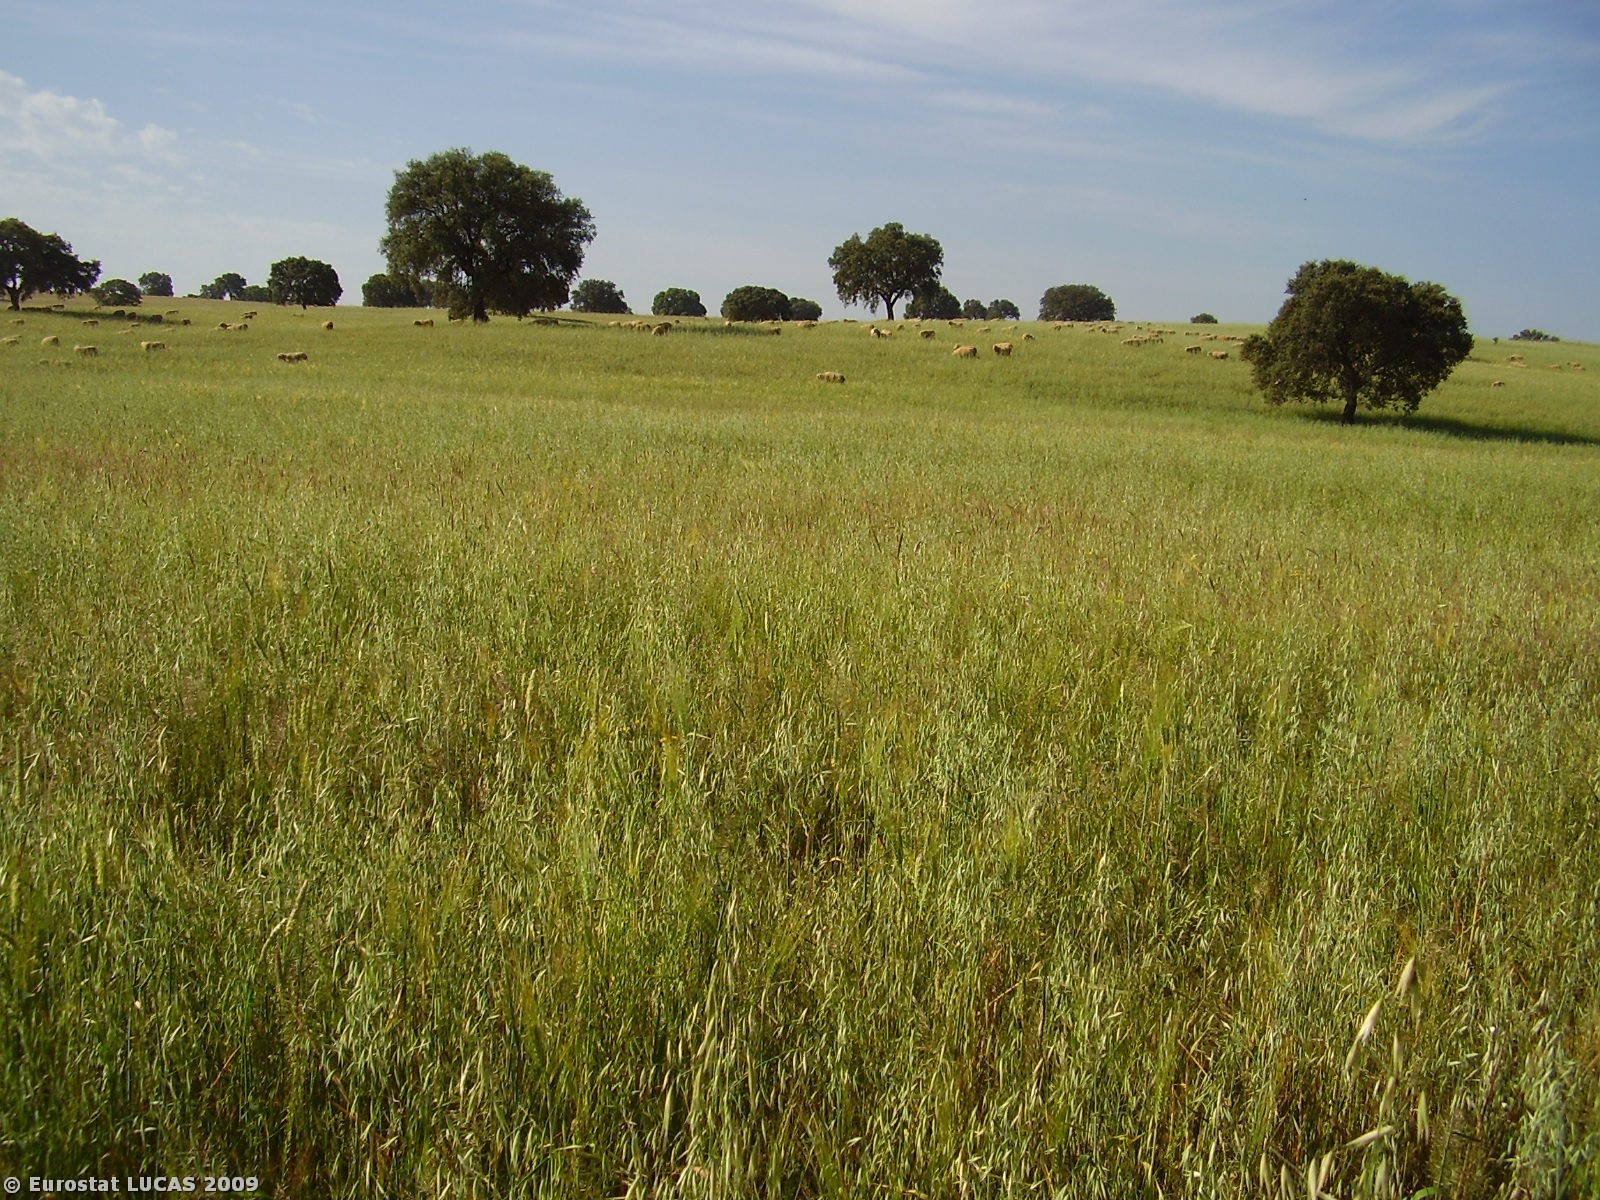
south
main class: Cropland
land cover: Mixed cereals for fodder
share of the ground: > 75 %
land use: Agriculture (excluding fallow land and kitchen gardens)
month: May
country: PT
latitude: 37.9531
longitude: -7.9299
